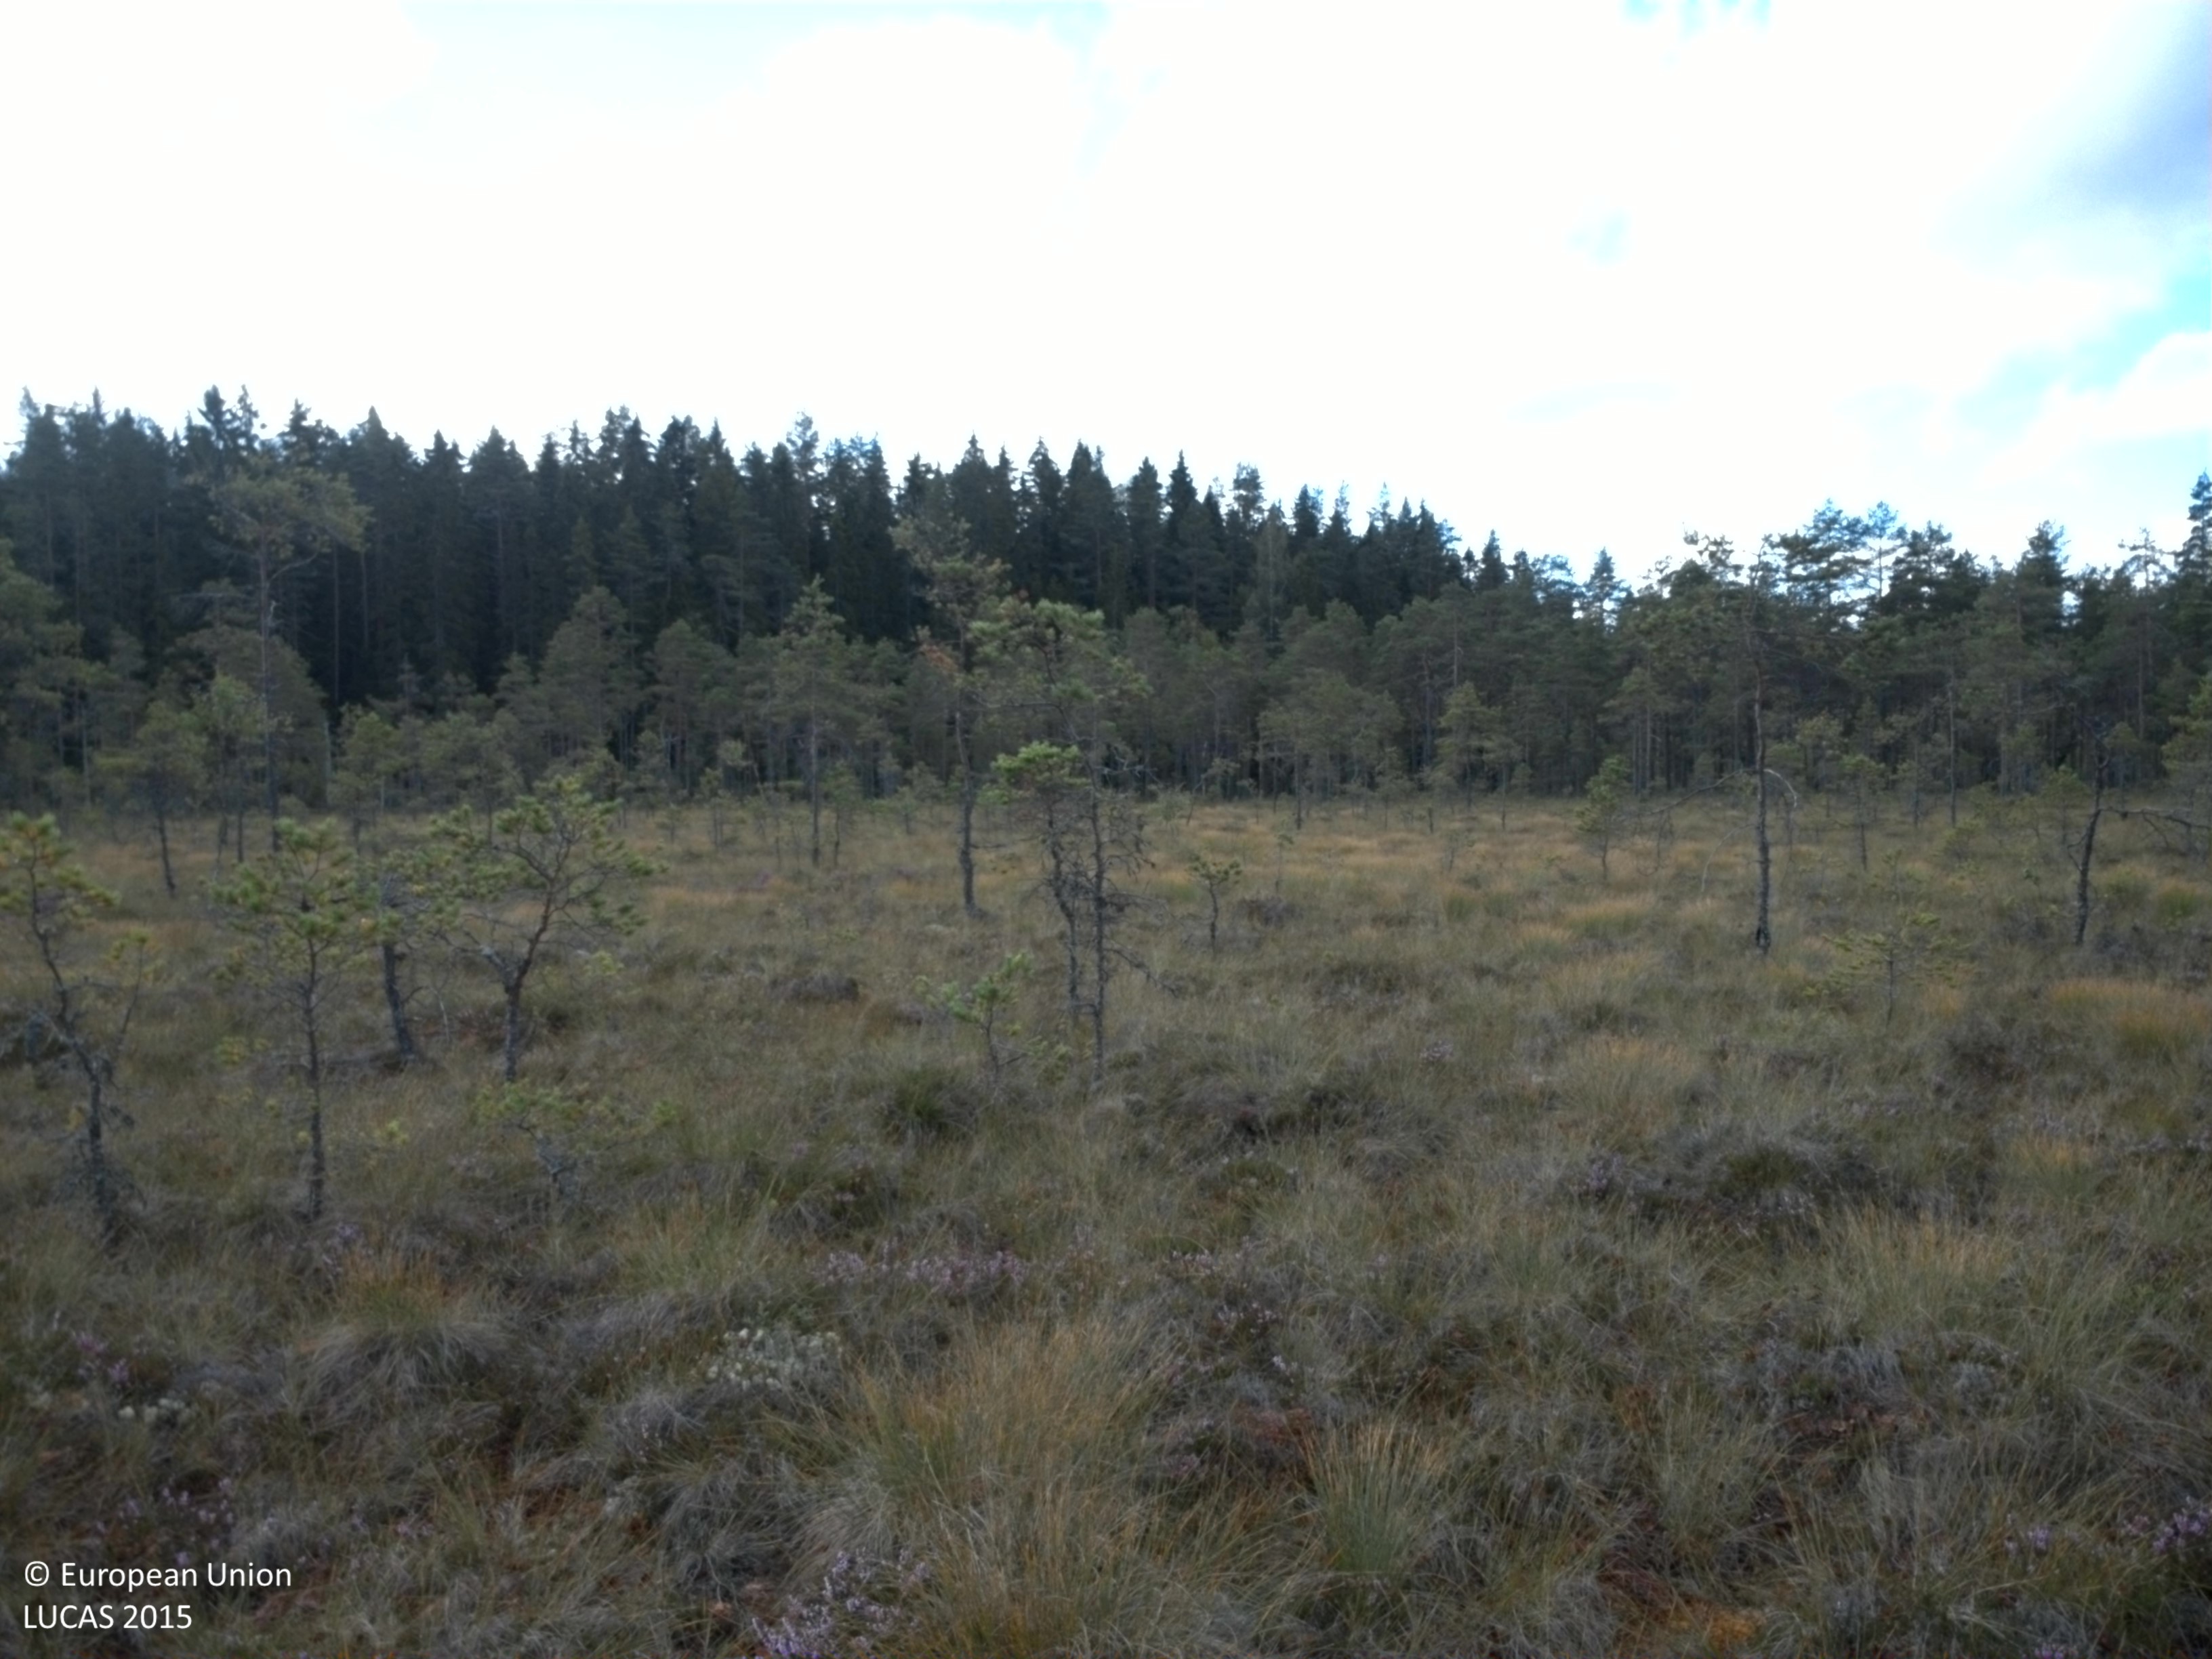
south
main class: Woodland
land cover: Pine dominated coniferous woodland
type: mire and swamp forests
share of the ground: < 10 %
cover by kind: lichens and mosses 40 %, herbaceous plants 30 %, shrubs 20 %, coniferous forest trees 10 %
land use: Semi-natural and natural areas not in use
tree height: < 5 m
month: August
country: SE
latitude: 59.4465
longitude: 11.9877
